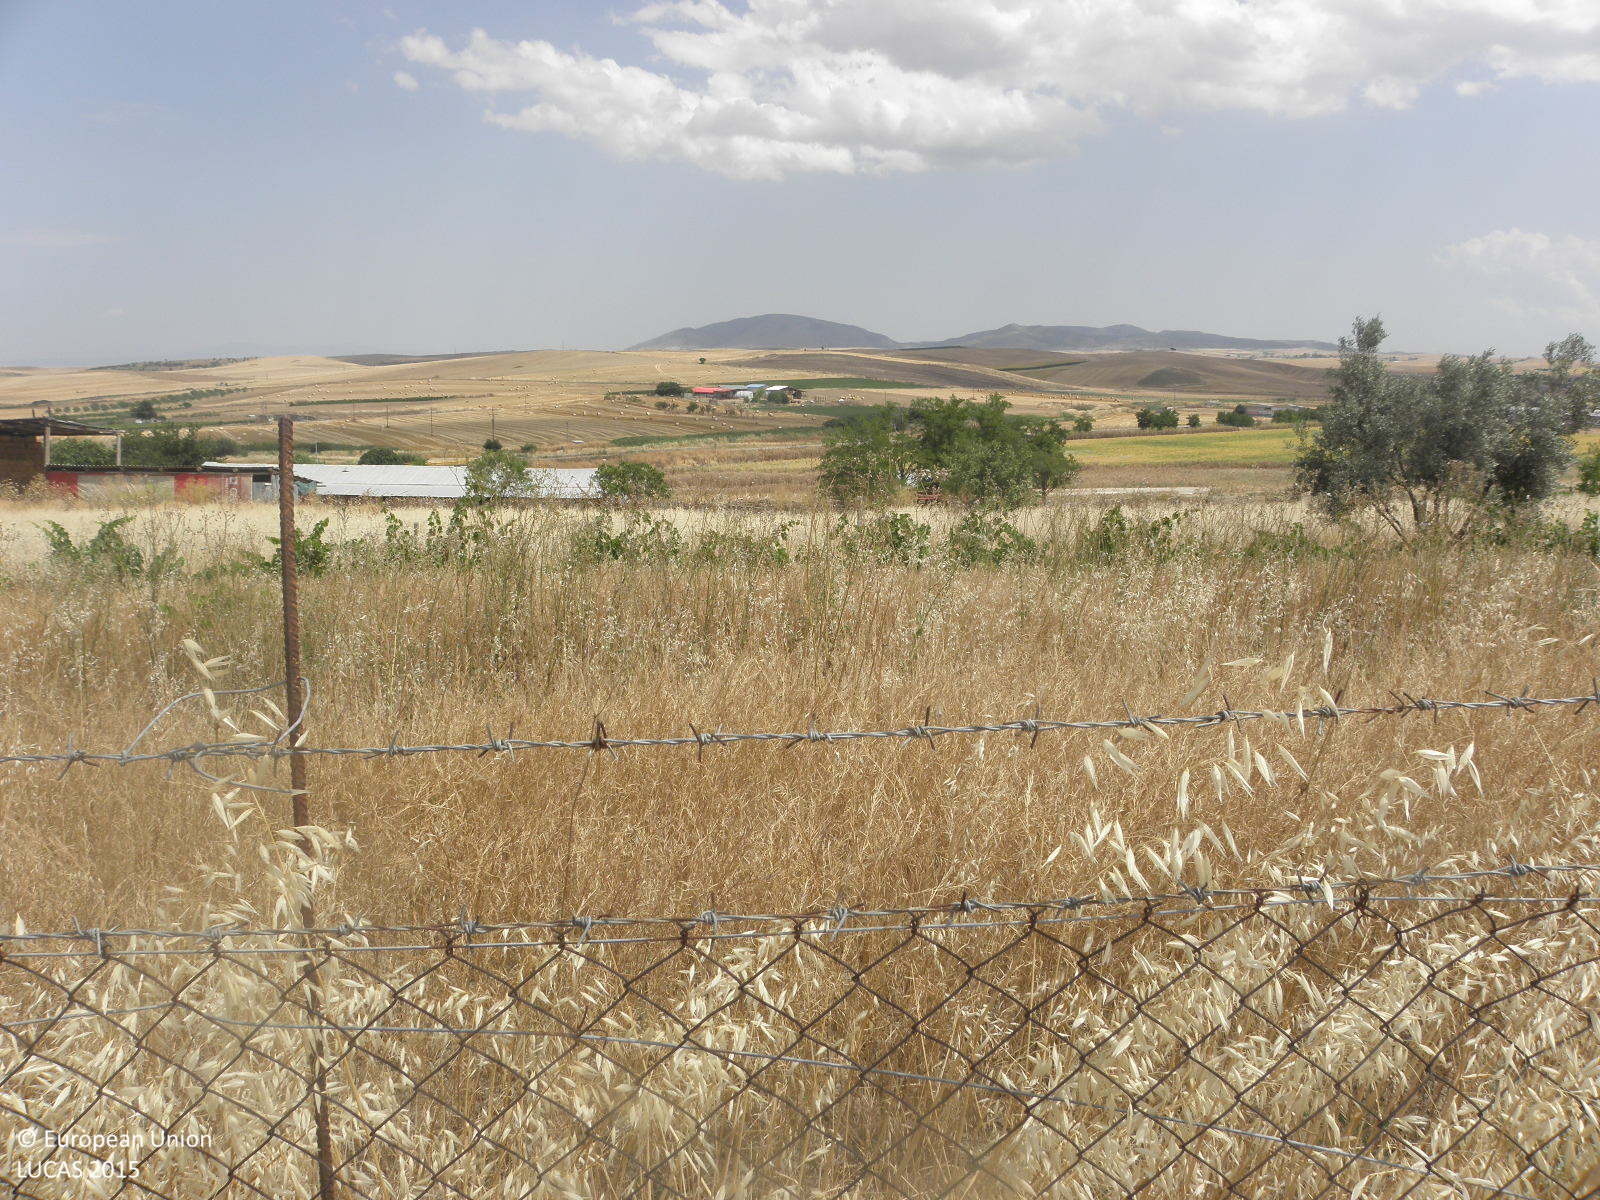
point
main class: Grassland
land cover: Spontaneously vegetated surfaces
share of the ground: > 75 %
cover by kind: herbaceous plants 100 %
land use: Fallow land
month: June
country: GR
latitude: 39.5053
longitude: 22.4674
